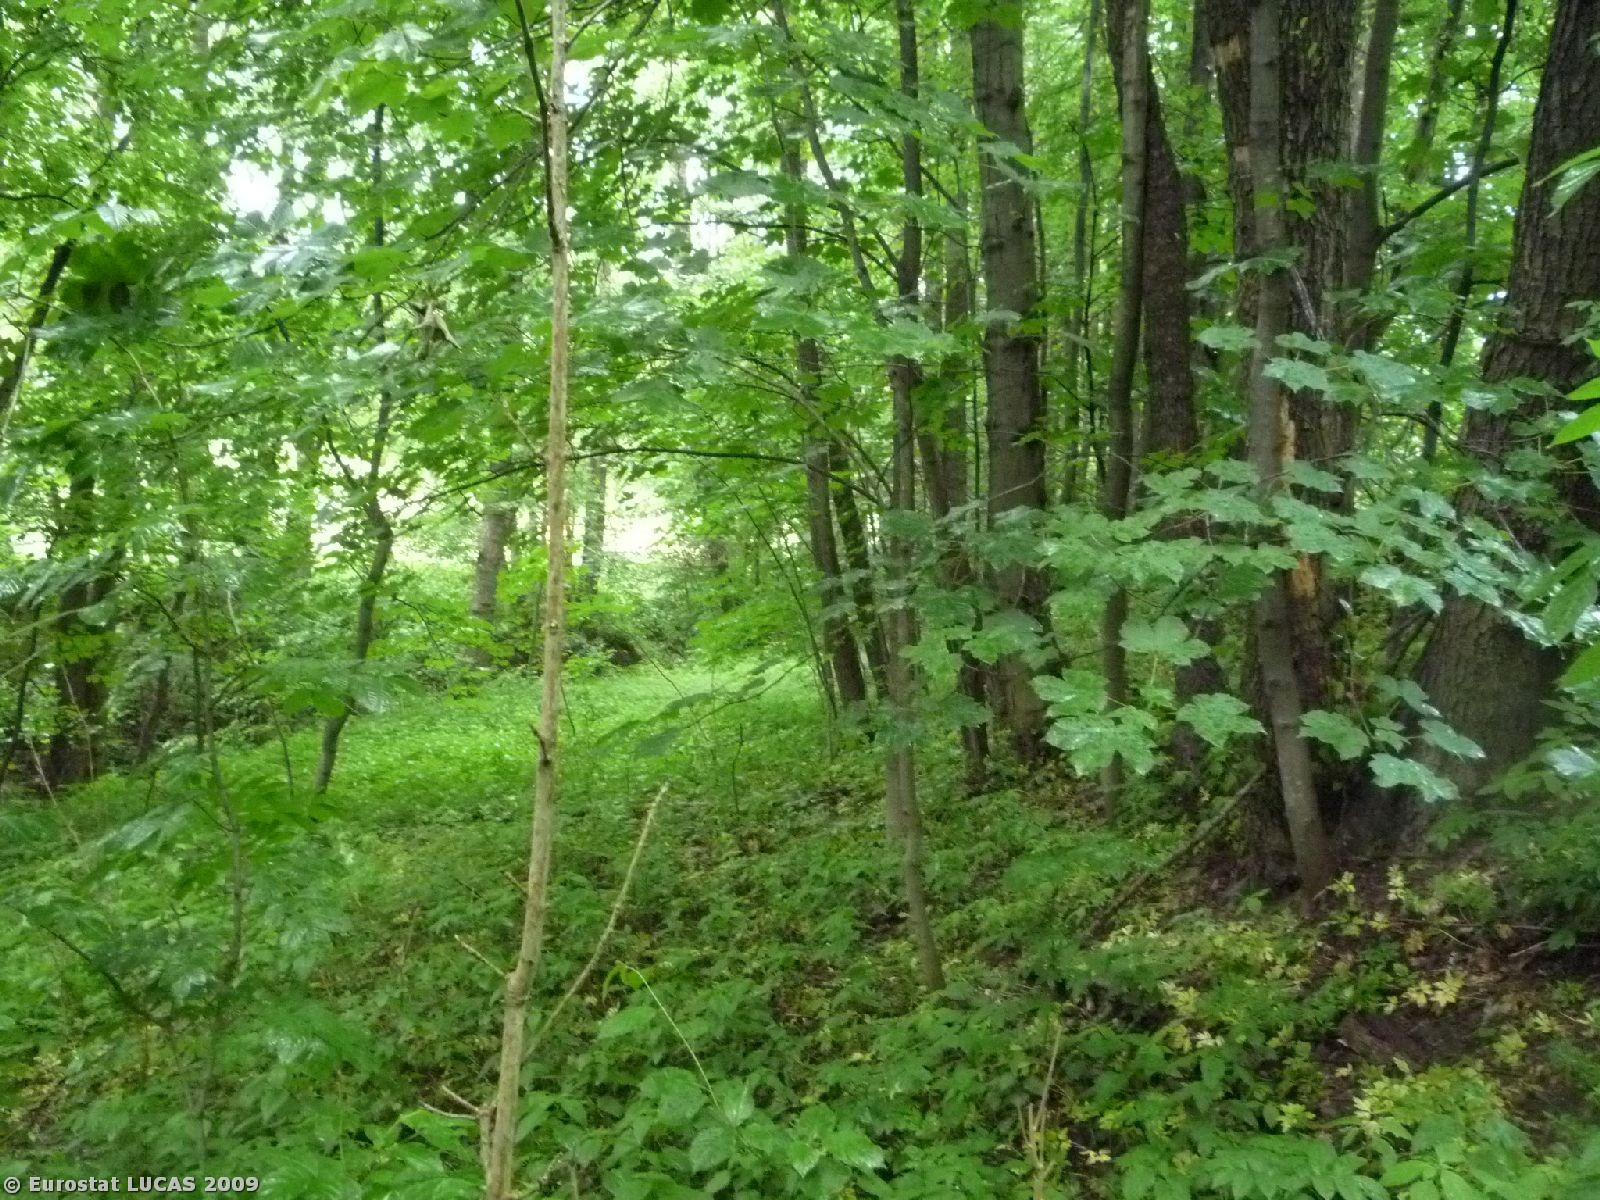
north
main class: Woodland
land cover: Broadleaved woodland
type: mesophytic deciduous forest
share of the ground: > 75 %
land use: Forestry
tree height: > 5 m
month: June
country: CZ
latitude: 50.6254
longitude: 15.5598
